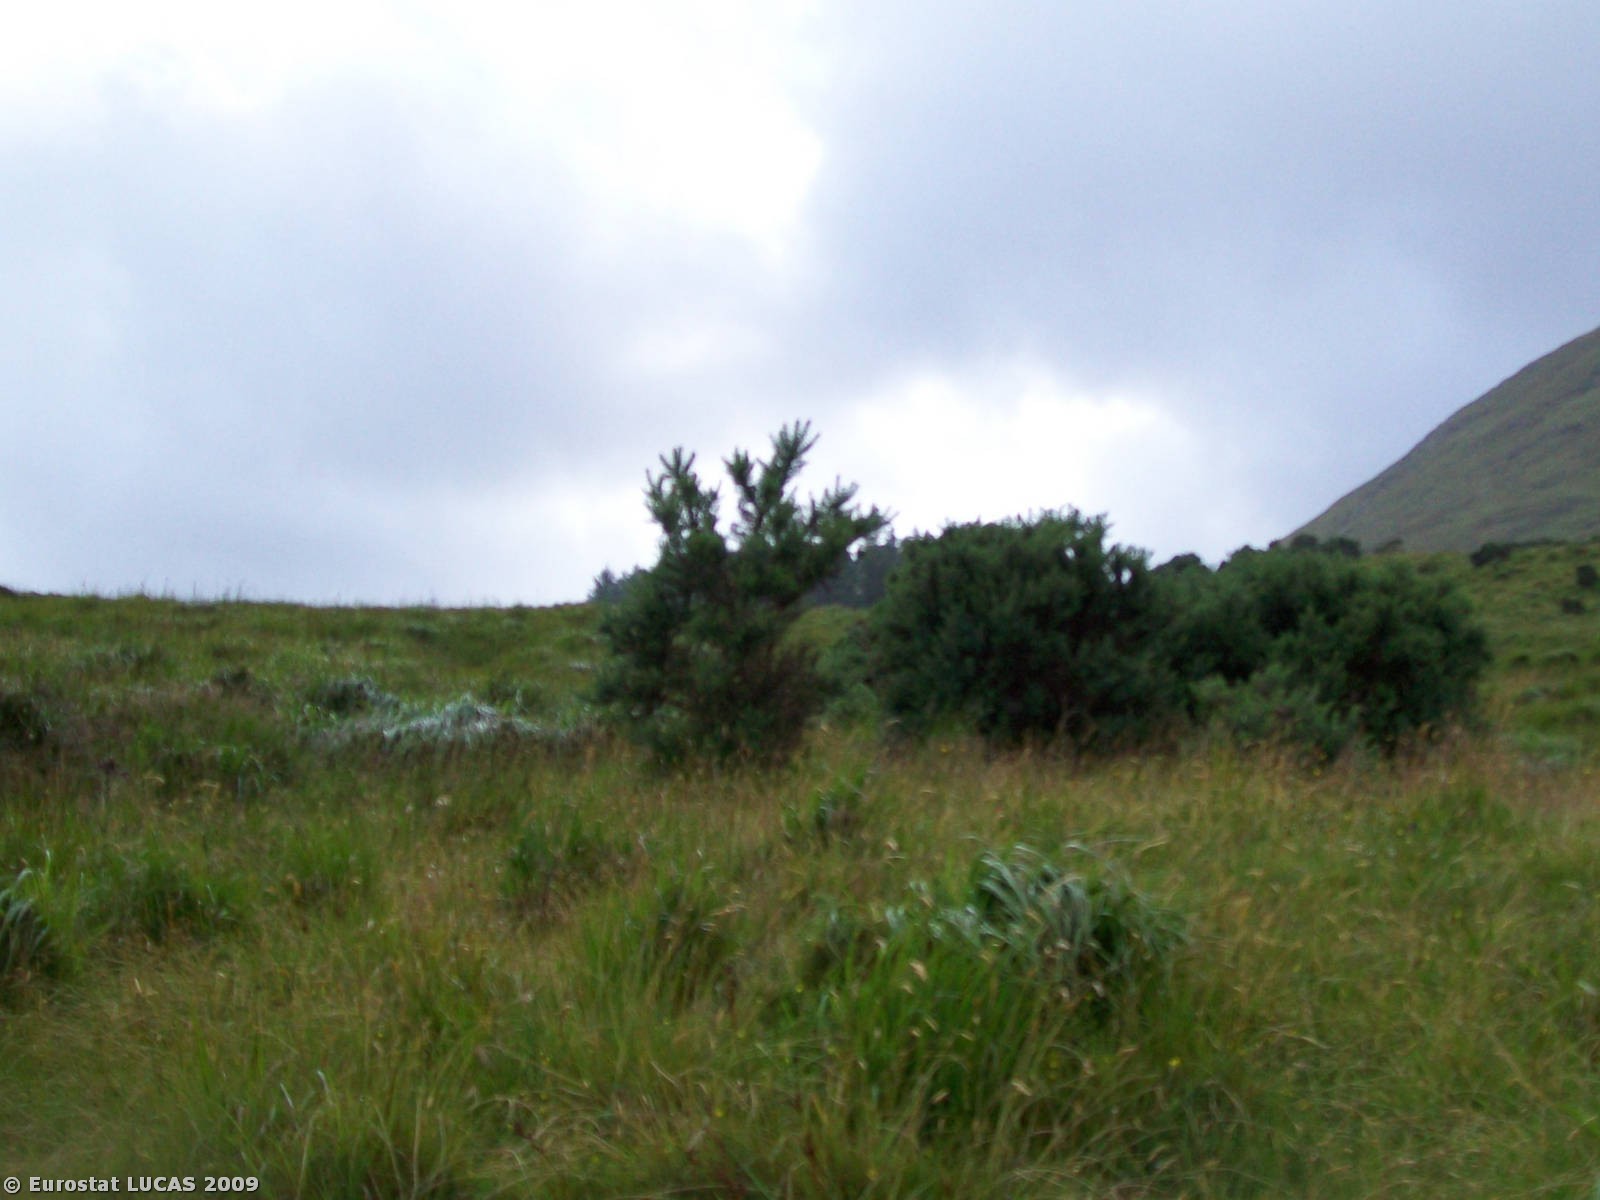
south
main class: Grassland
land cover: Grassland without tree/shrub cover
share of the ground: > 75 %
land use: Agriculture (excluding fallow land and kitchen gardens)
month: July
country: IE
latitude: 53.6094
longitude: -9.5034
